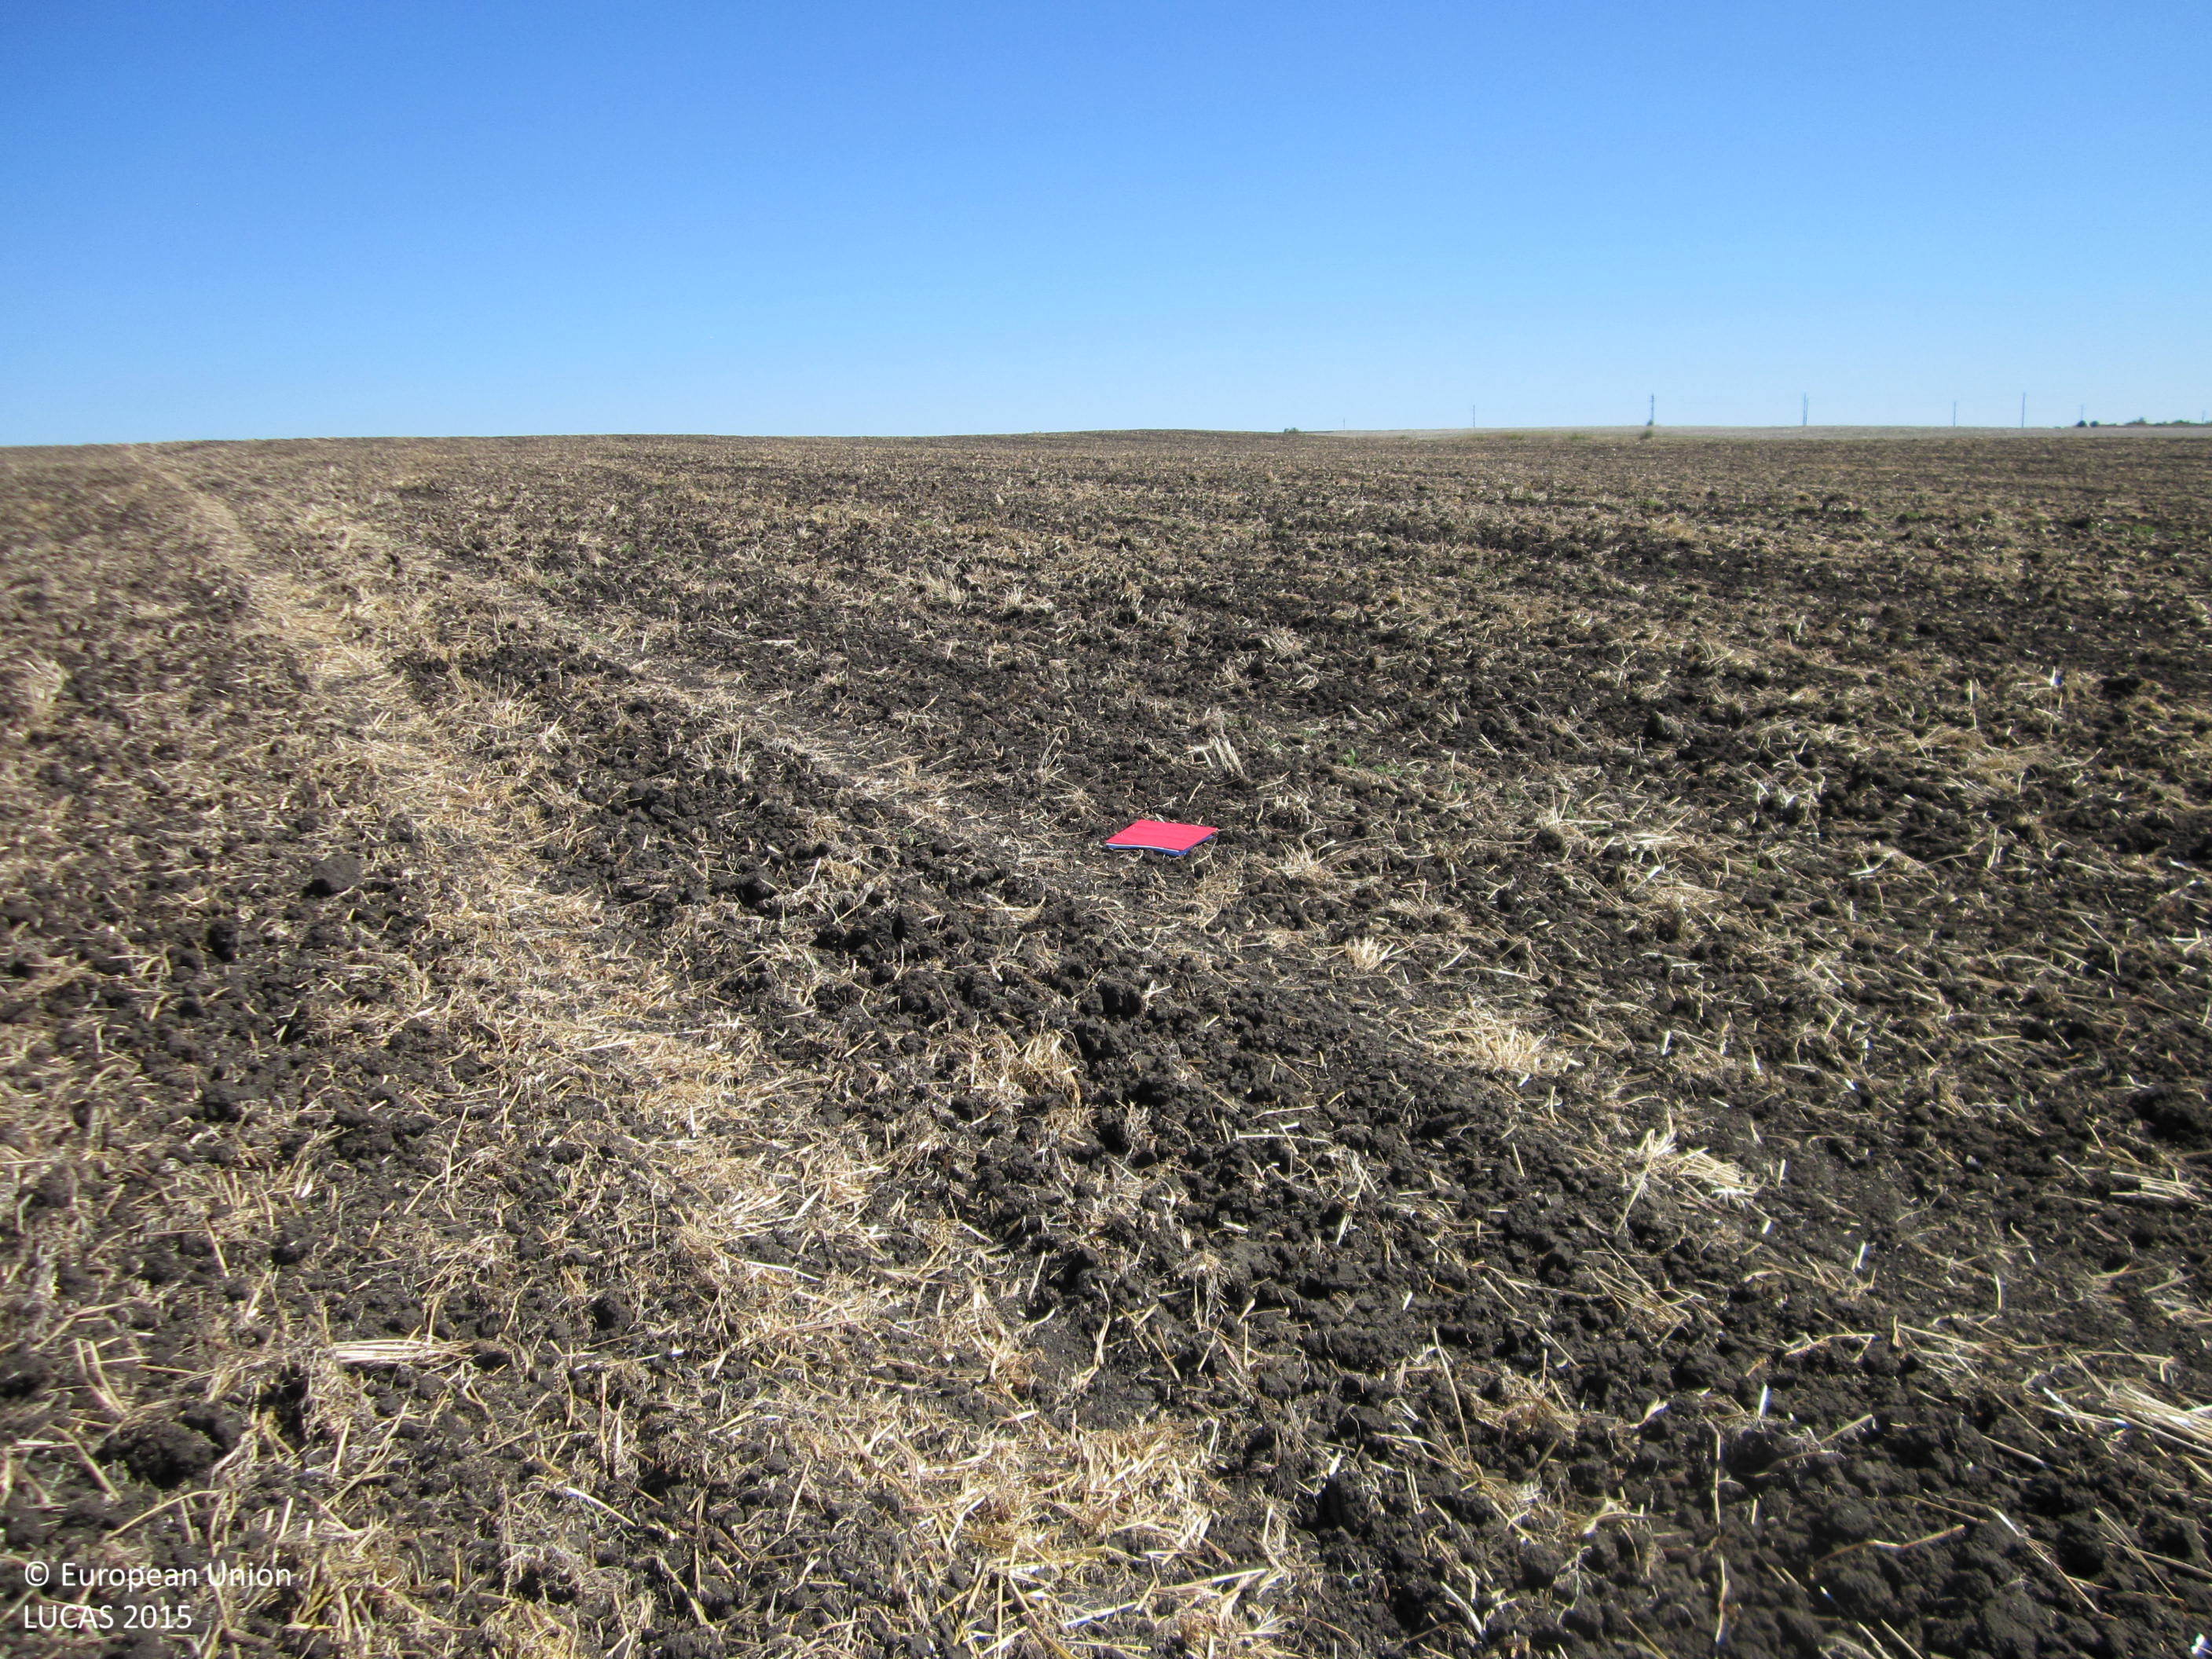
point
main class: Cropland
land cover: Common wheat
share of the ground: 10 - 25 %
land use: Agriculture (excluding fallow land and kitchen gardens)
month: September
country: BG
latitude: 42.5587
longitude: 27.0490
